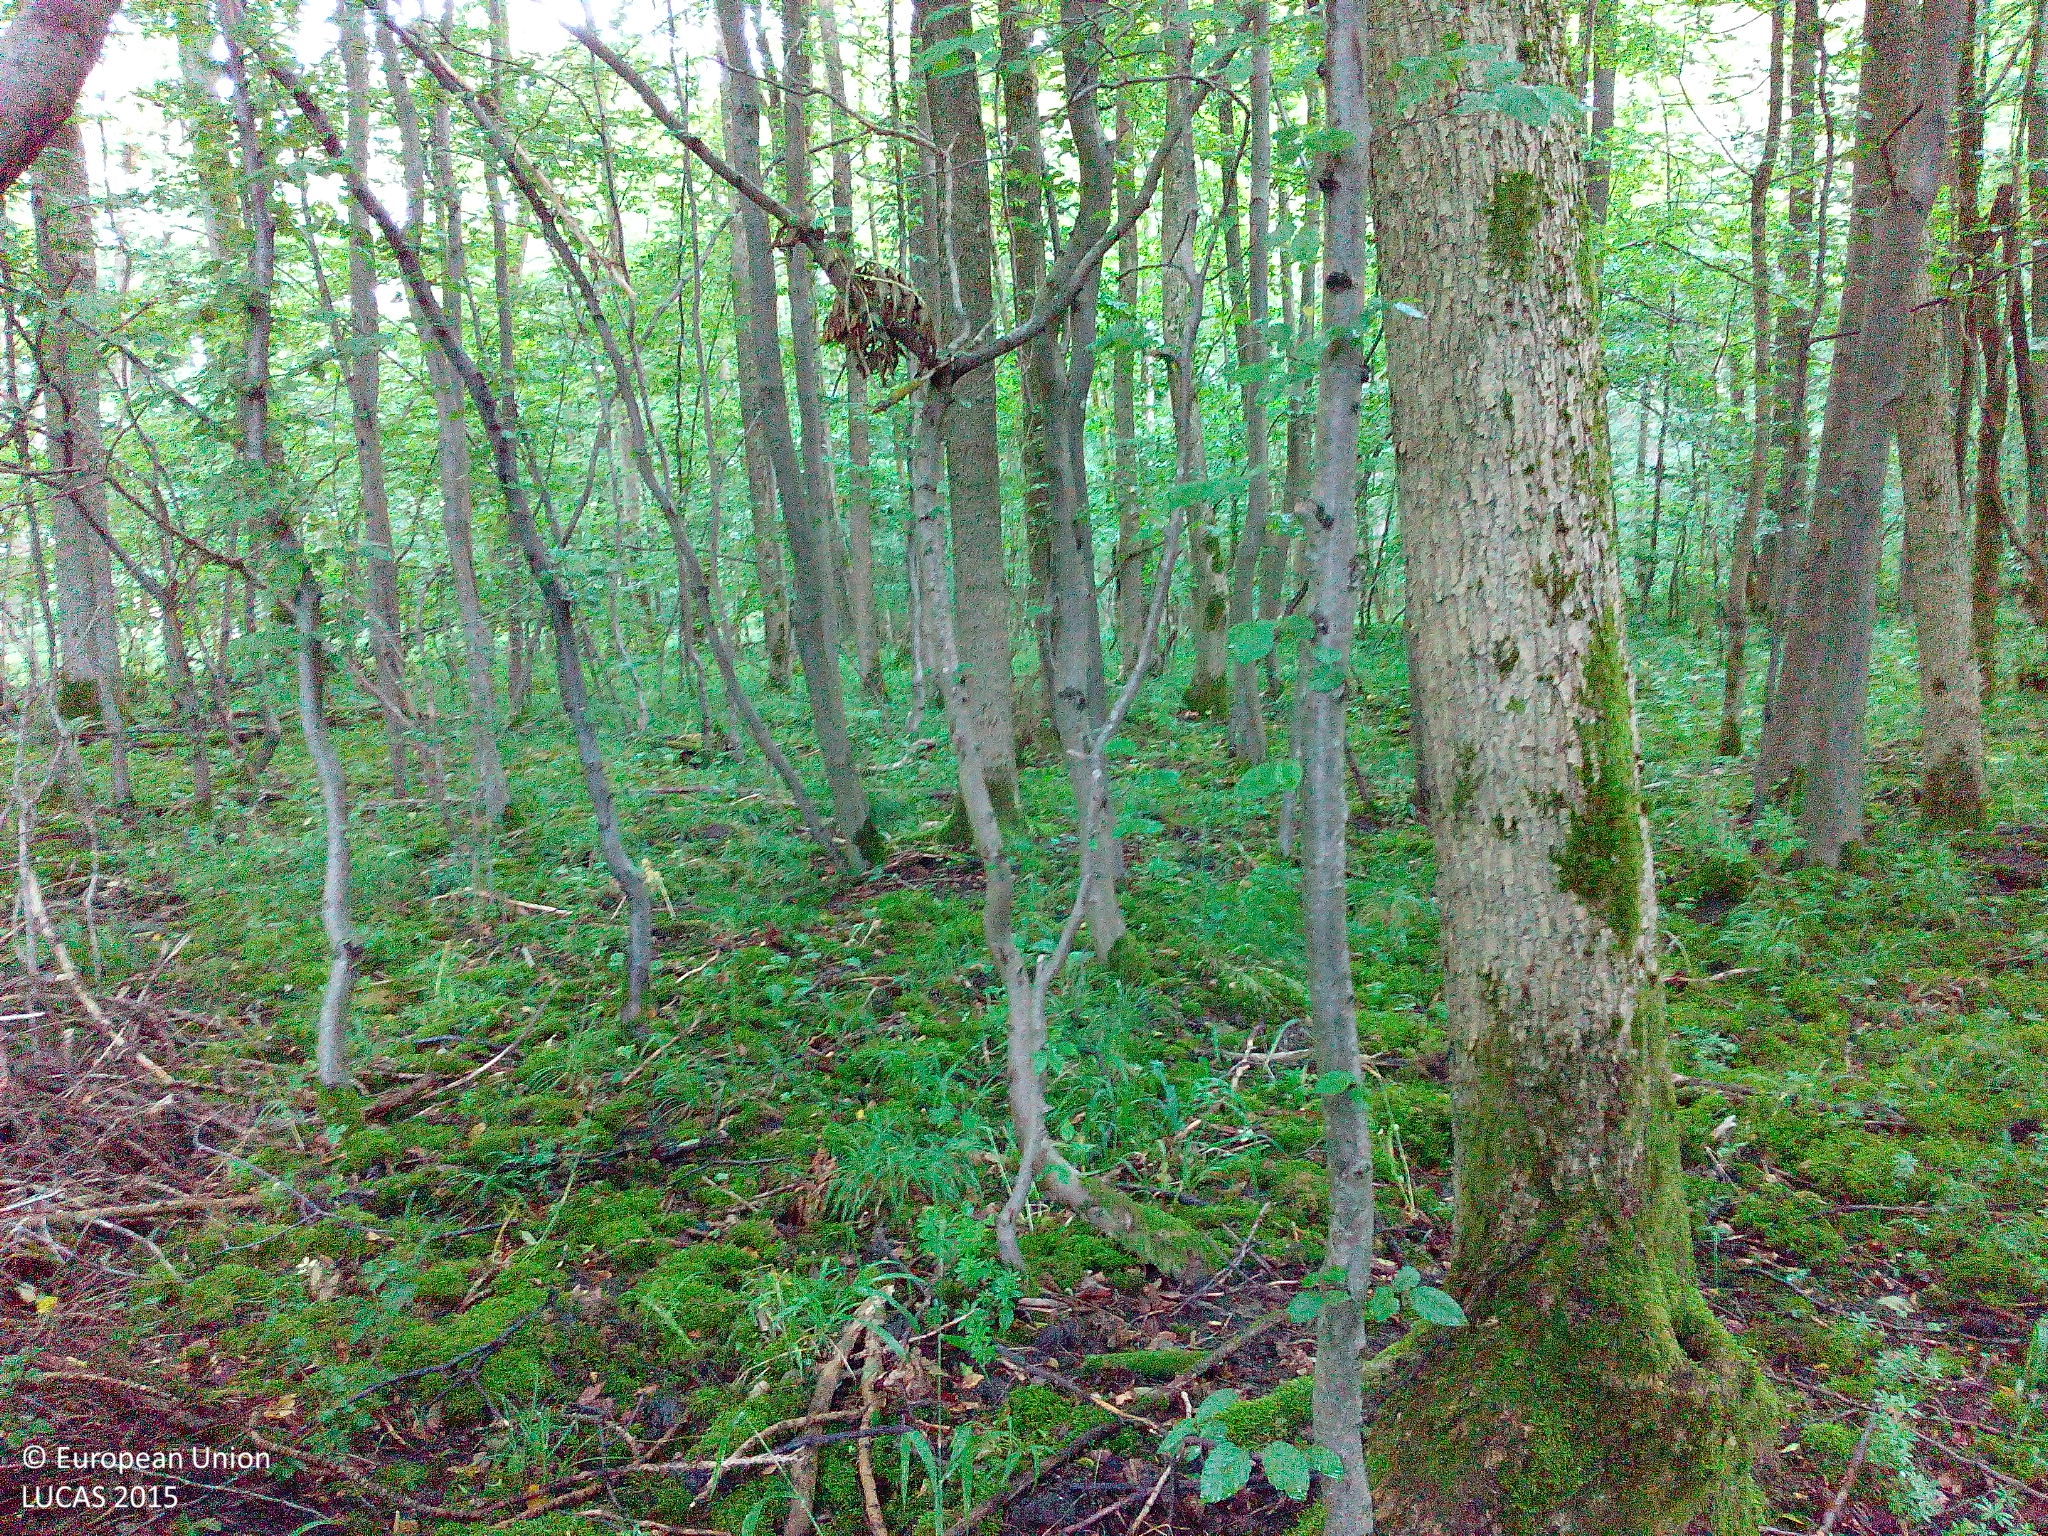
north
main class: Woodland
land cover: Broadleaved woodland
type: acidophilous oak and oak-birch forest
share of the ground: > 75 %
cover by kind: broadleaved forest trees 100 %
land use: Forestry
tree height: > 5 m
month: July
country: DE
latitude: 50.6696
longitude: 9.8727
